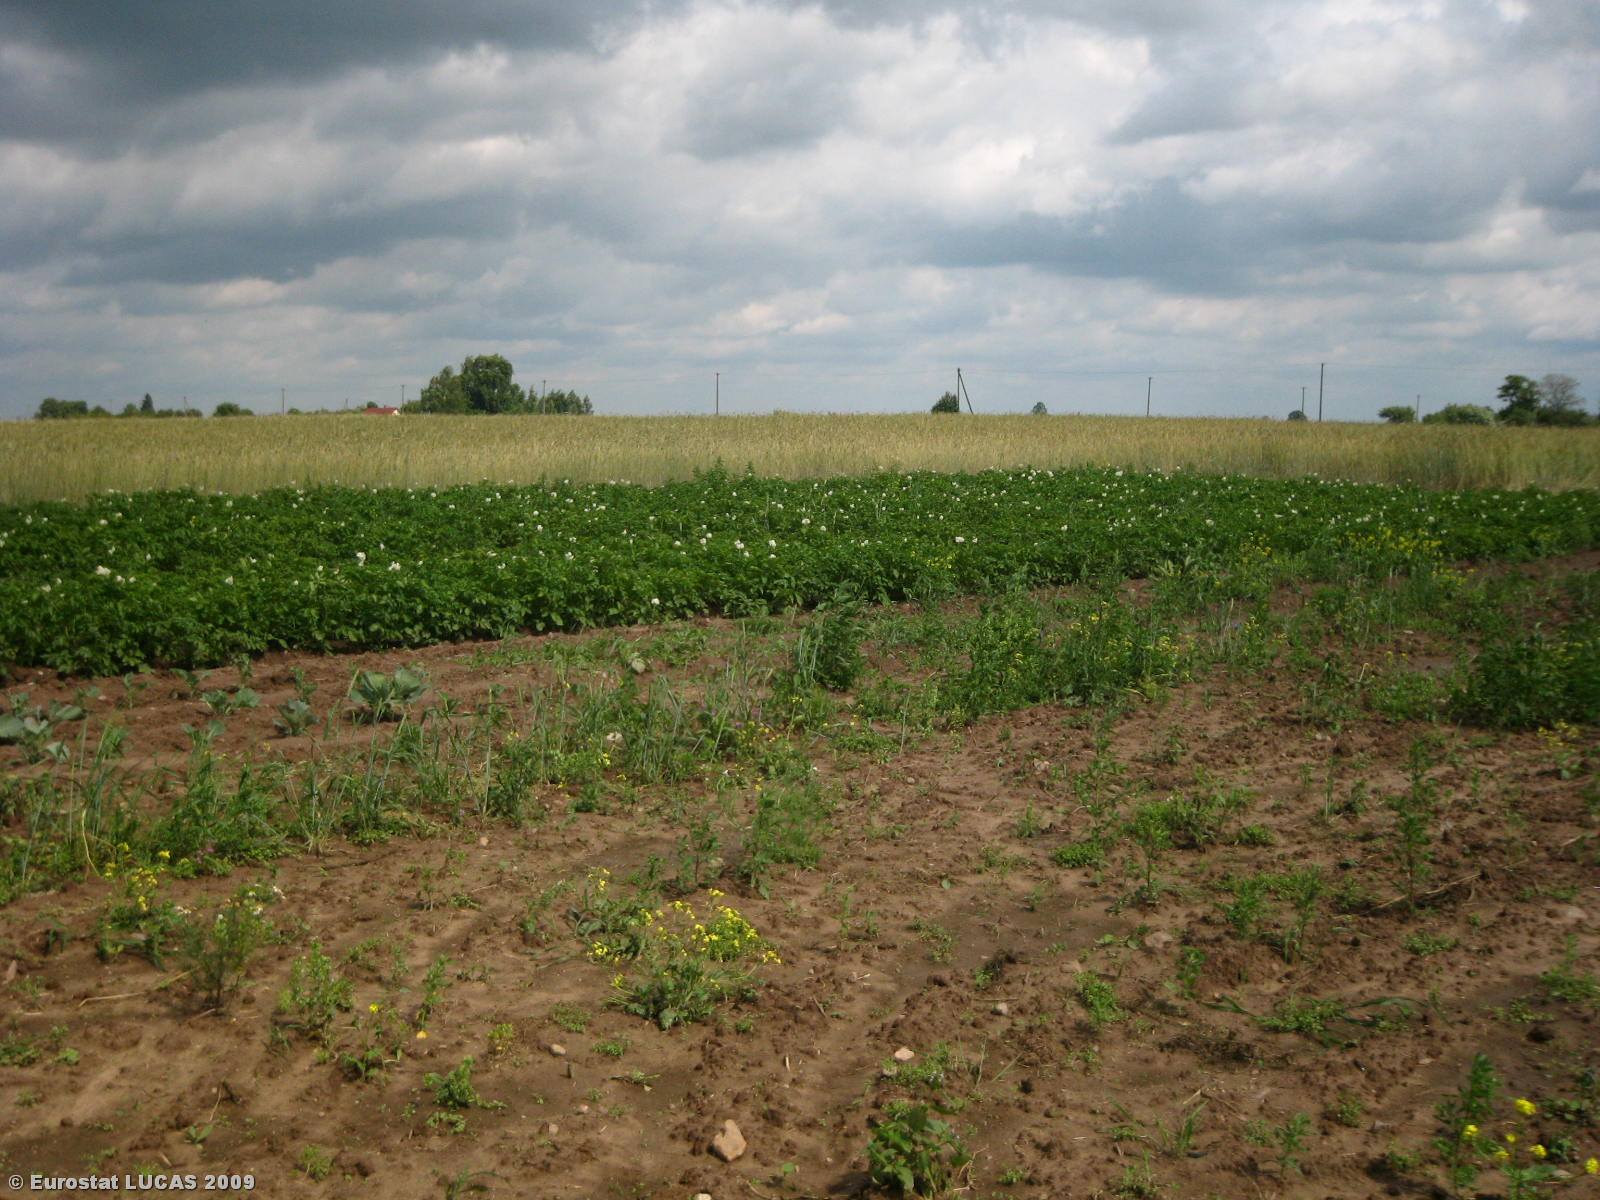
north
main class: Grassland
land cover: Grassland without tree/shrub cover
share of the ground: 25 - 50 %
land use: Fallow land
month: July
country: LT
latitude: 55.2760
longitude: 24.7299
